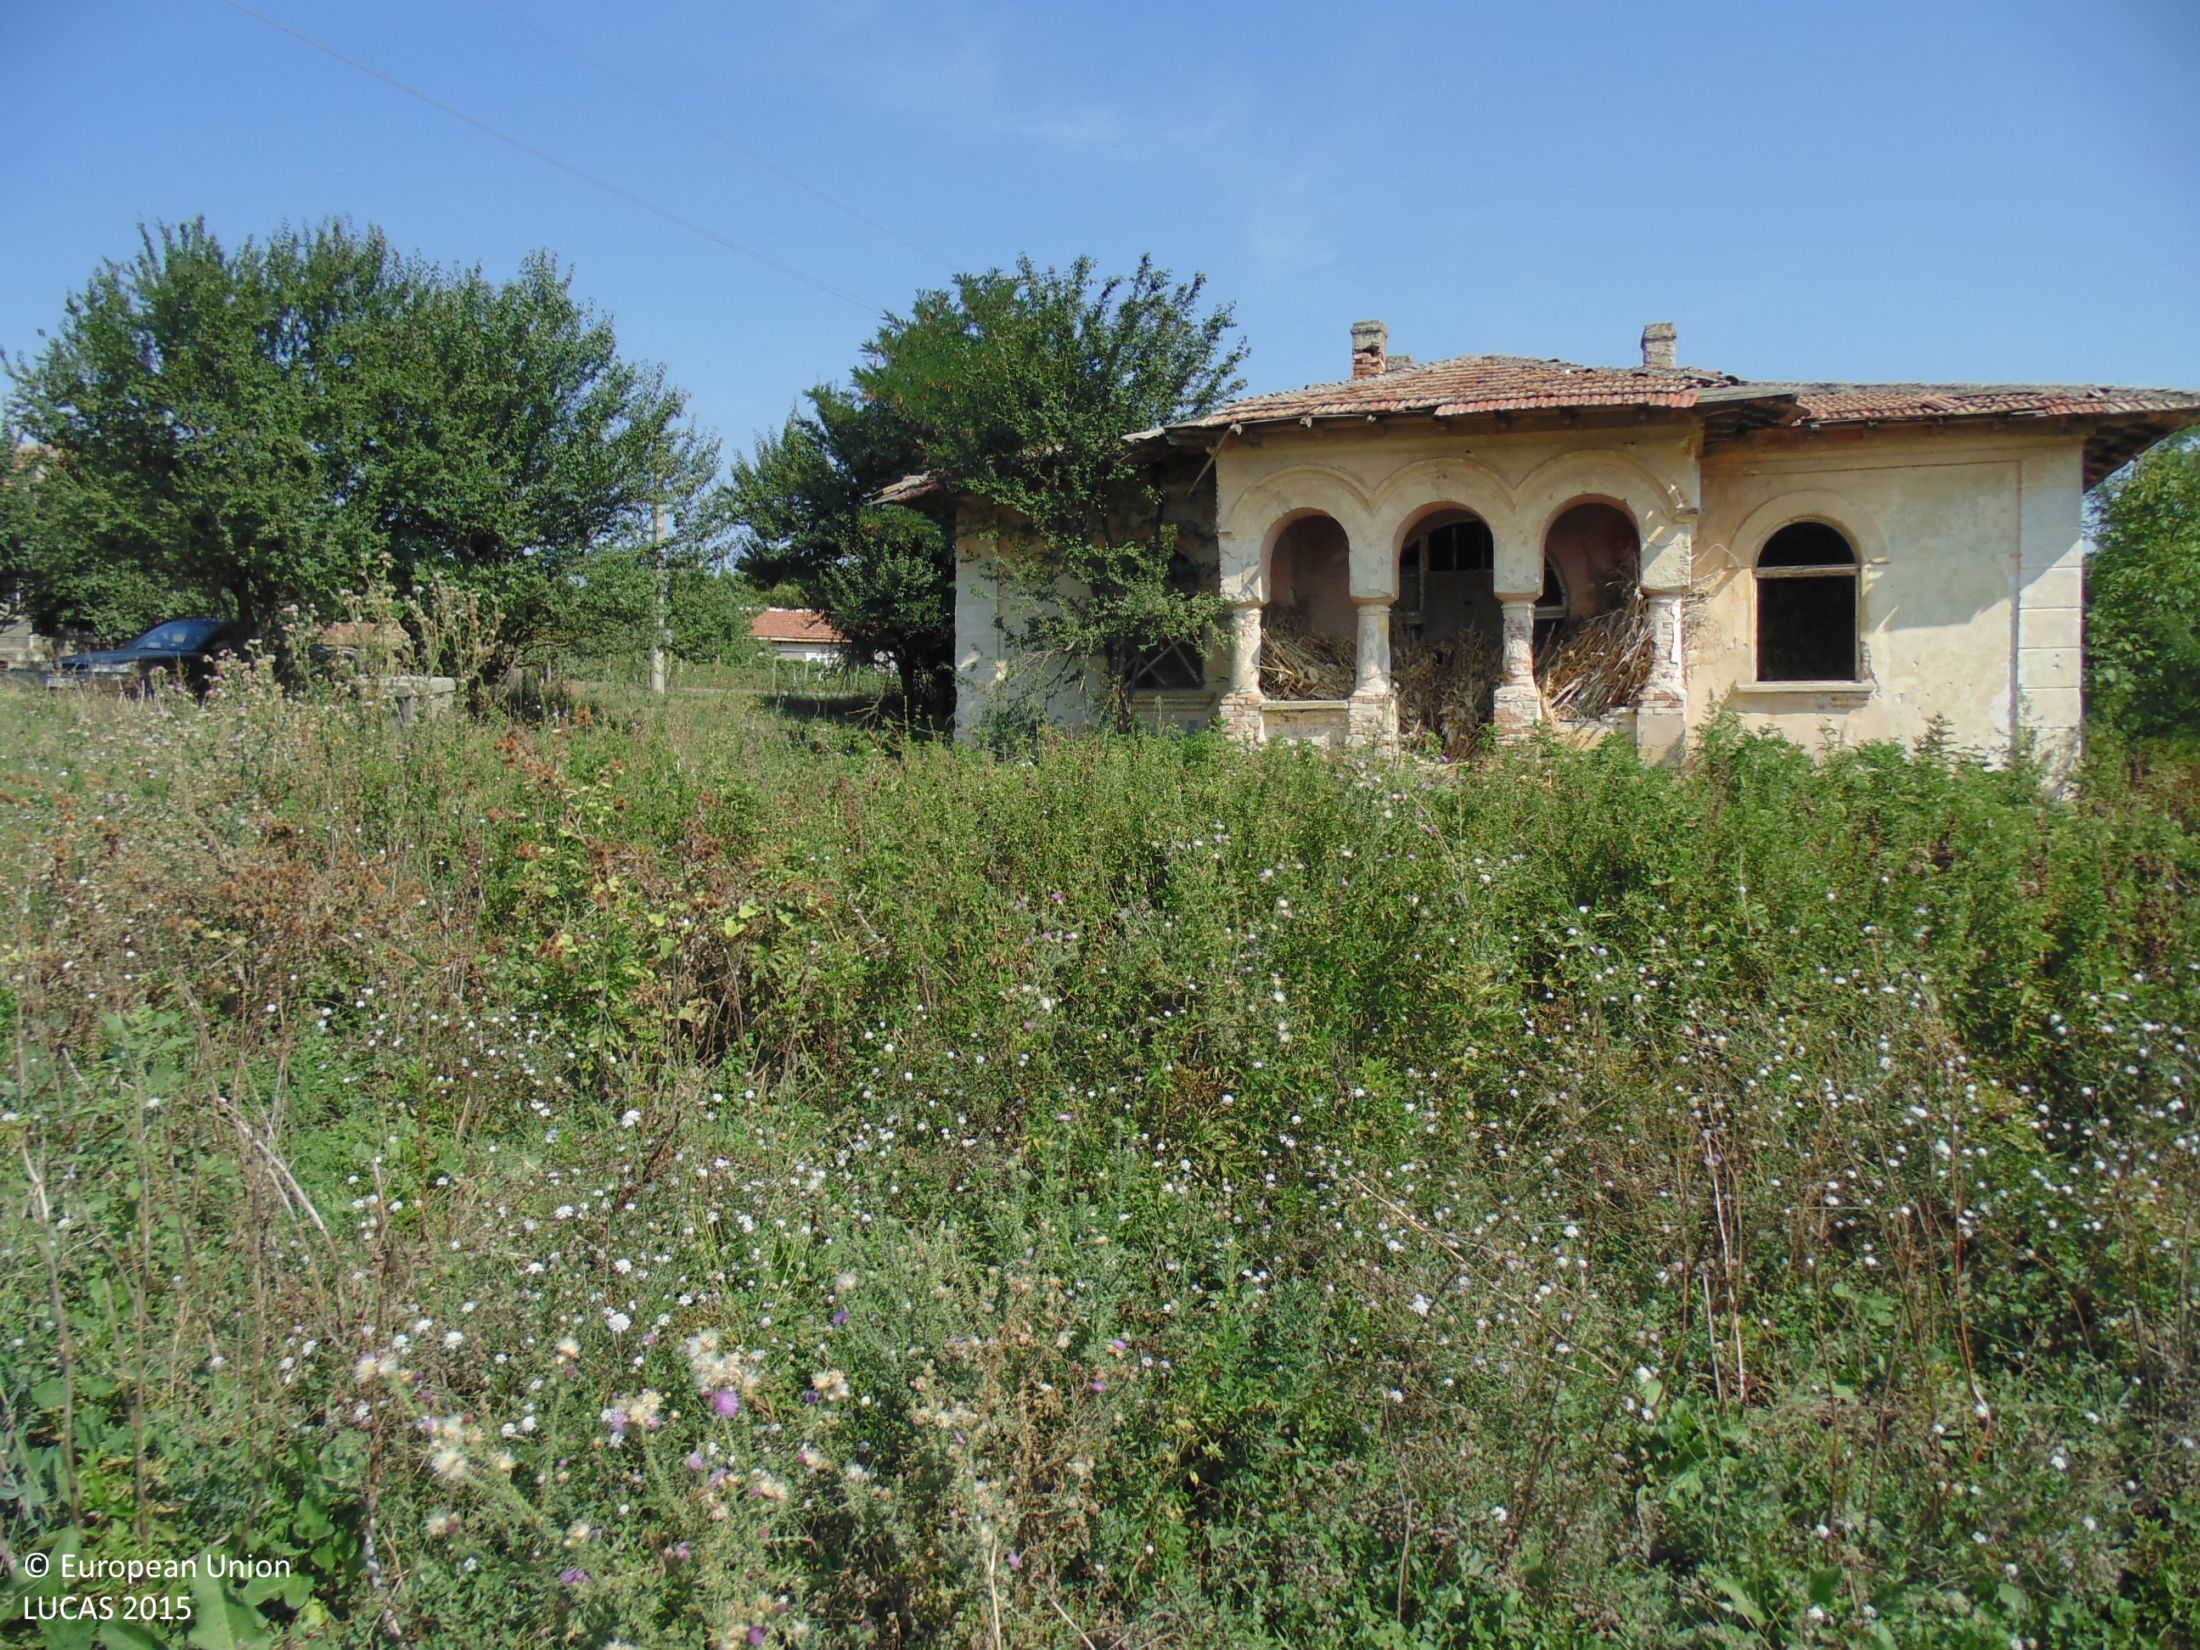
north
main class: Grassland
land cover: Spontaneously vegetated surfaces
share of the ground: > 75 %
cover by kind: herbaceous plants 100 %
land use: Residential
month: September
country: BG
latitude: 43.7415
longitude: 27.0205
